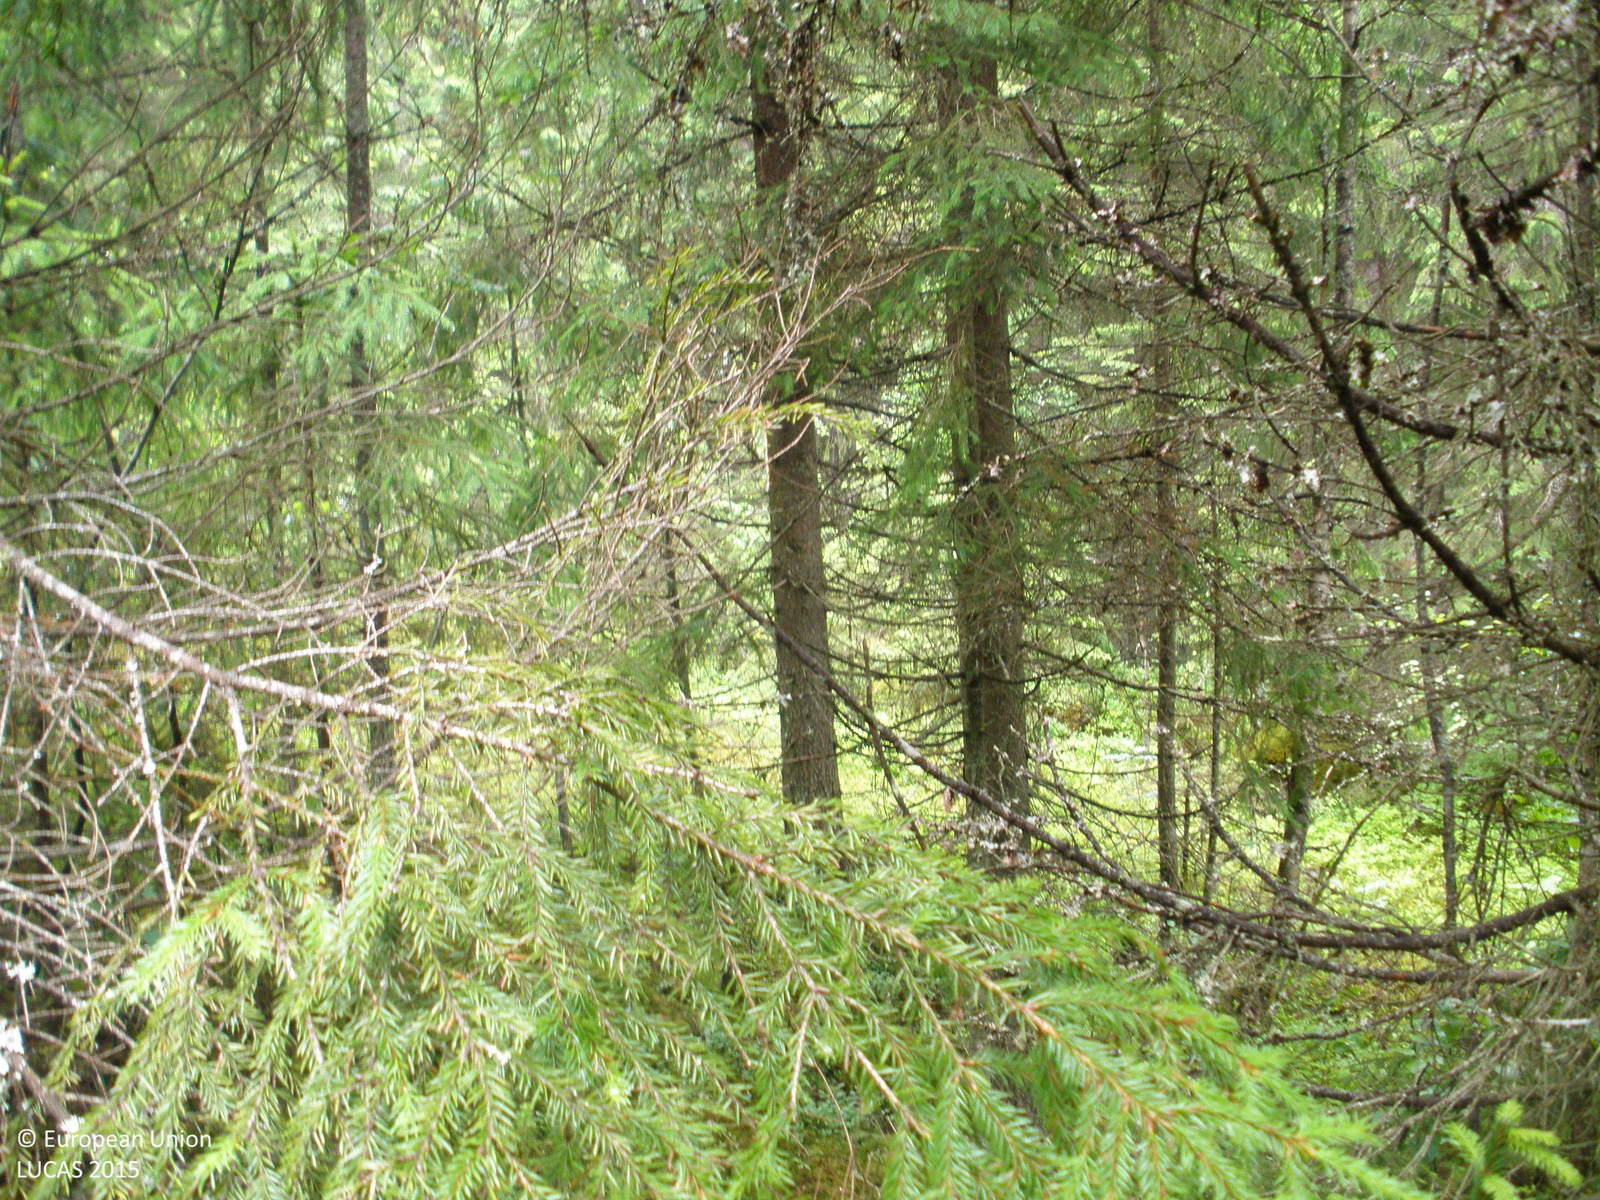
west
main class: Woodland
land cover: Spruce dominated mixed woodland
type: boreal forest
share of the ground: > 75 %
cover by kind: coniferous forest trees 60 %, broadleaved forest trees 25 %, lichens and mosses 15 %
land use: Forestry
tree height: > 5 m
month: June
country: FI
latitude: 61.0364
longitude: 23.6173
